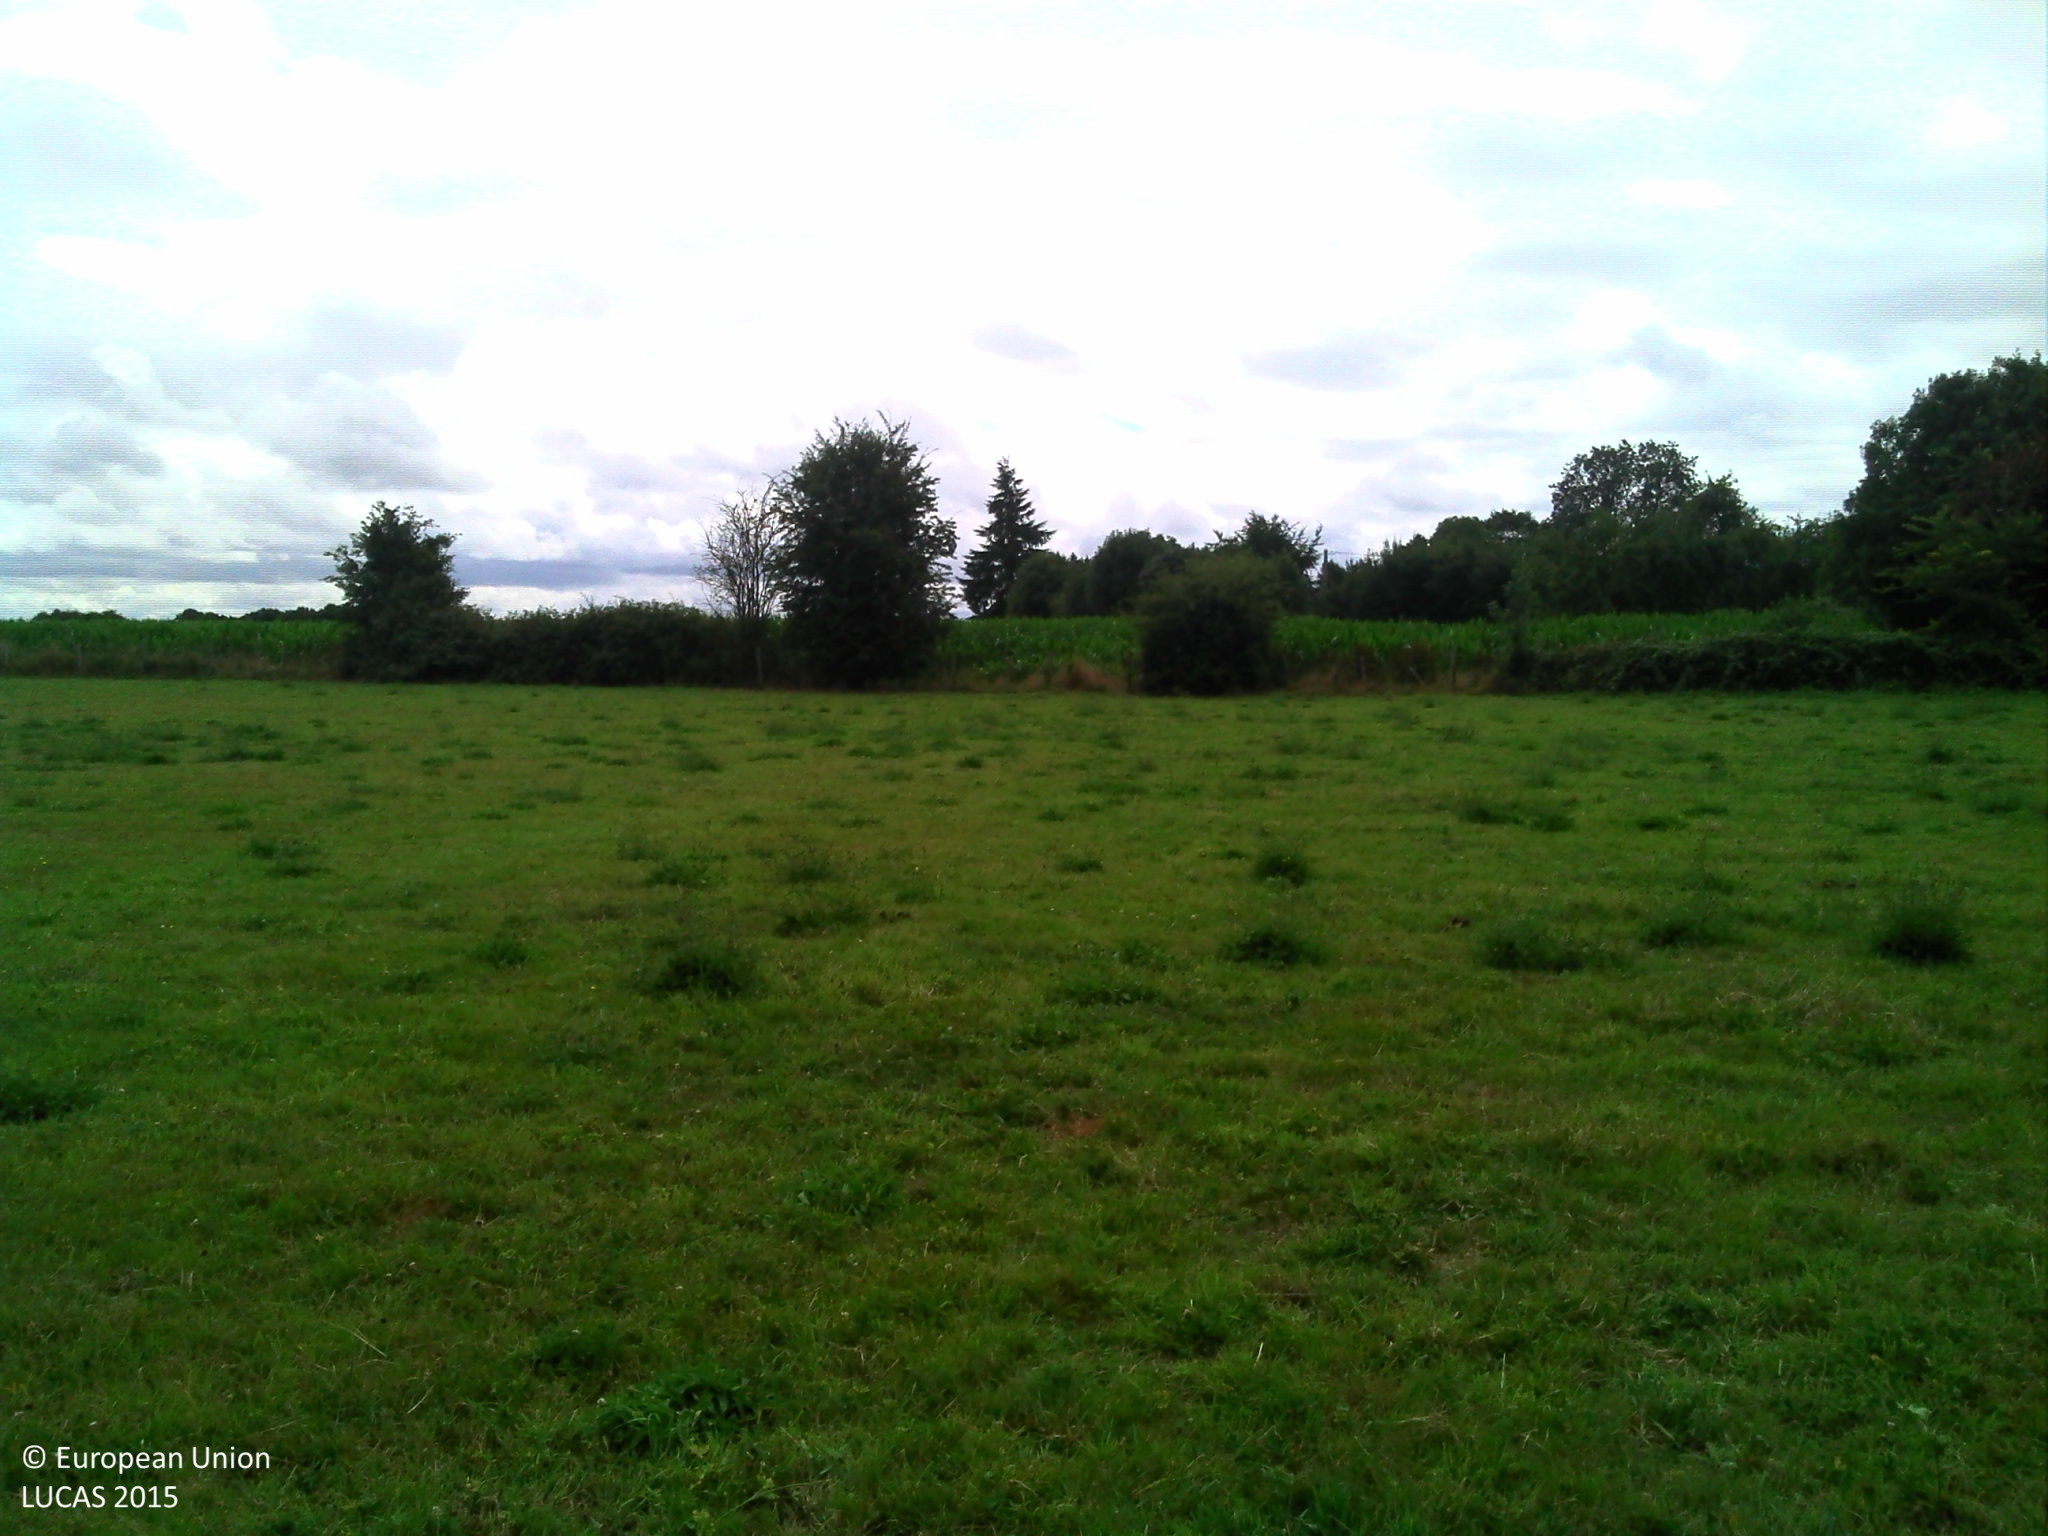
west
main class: Grassland
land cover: Grassland without tree/shrub cover
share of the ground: > 75 %
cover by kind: herbaceous plants 100 %
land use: Agriculture (excluding fallow land and kitchen gardens)
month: July
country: FR
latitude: 48.8608
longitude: 0.4734
